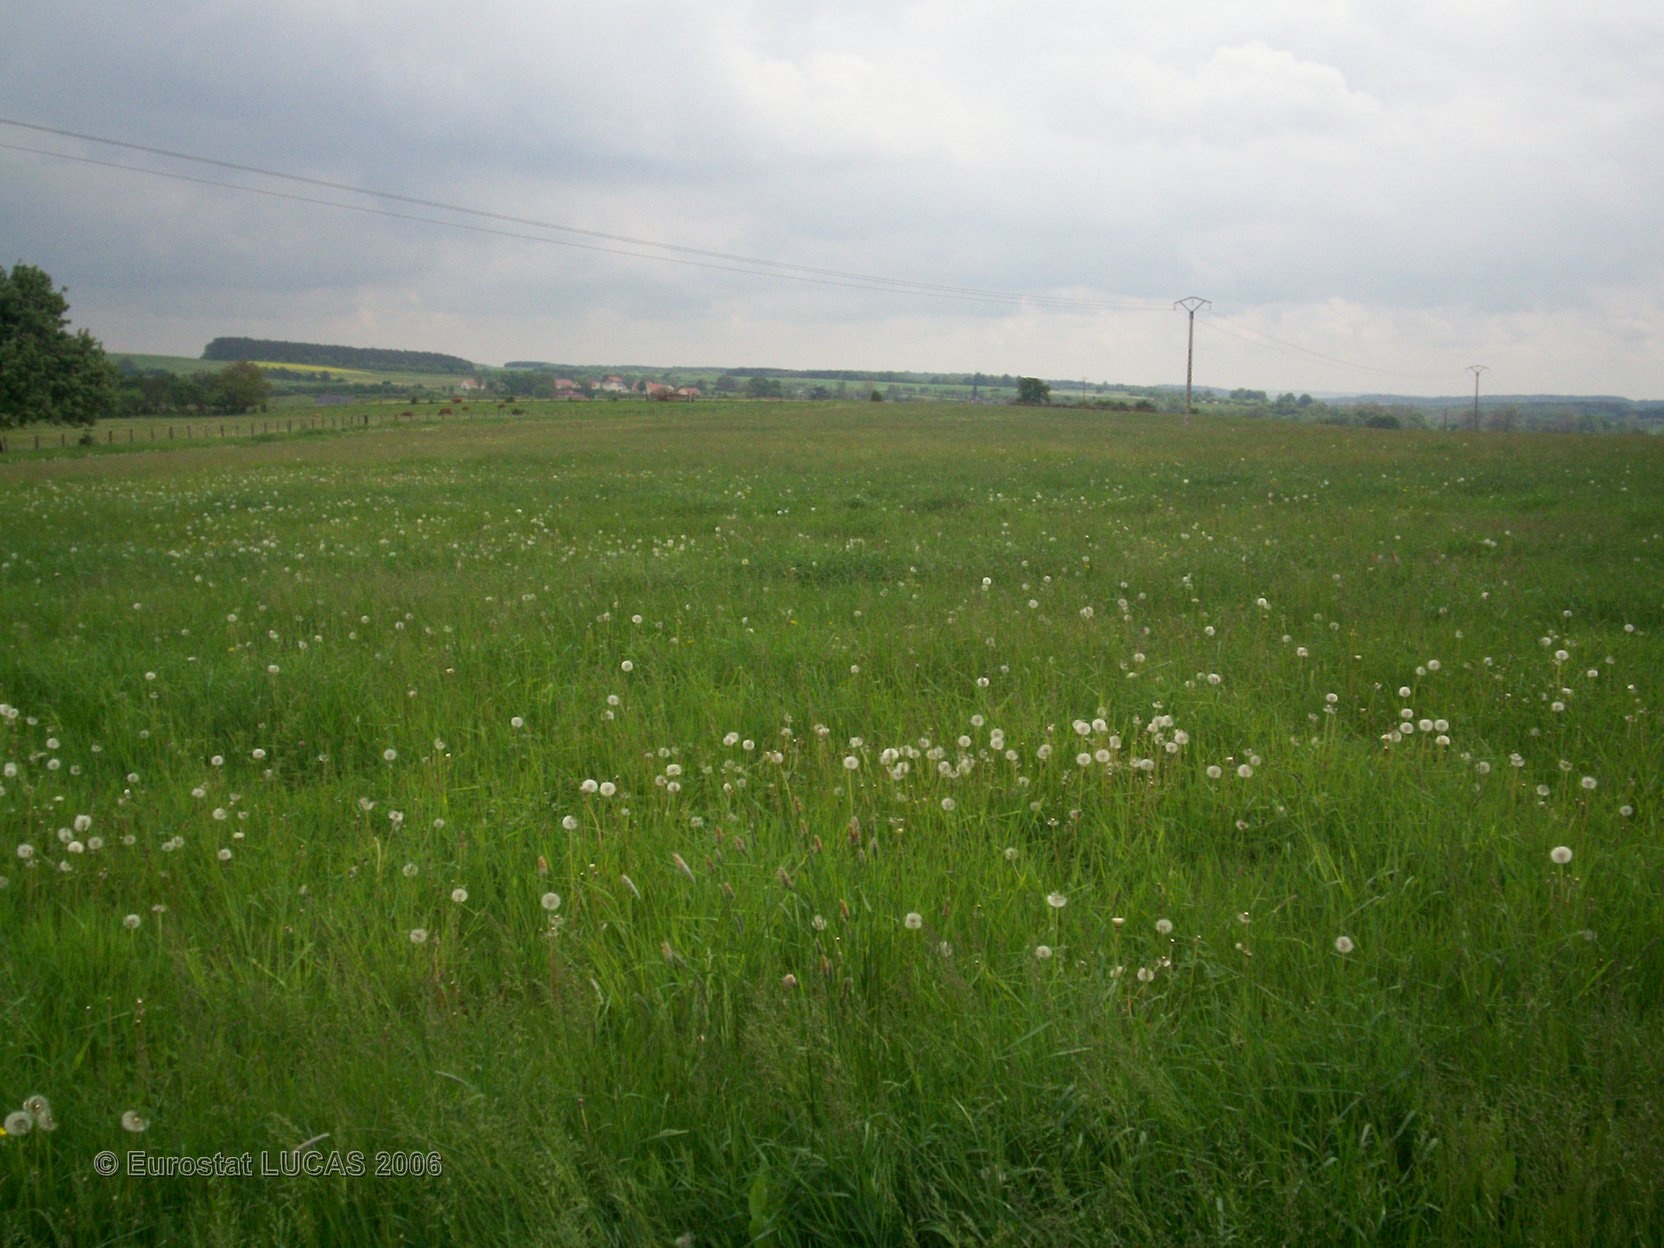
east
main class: Grassland
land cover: Grassland without tree/shrub cover
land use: Agriculture (excluding fallow land and kitchen gardens)
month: May
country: FR
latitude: 49.3536
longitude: 6.4067
